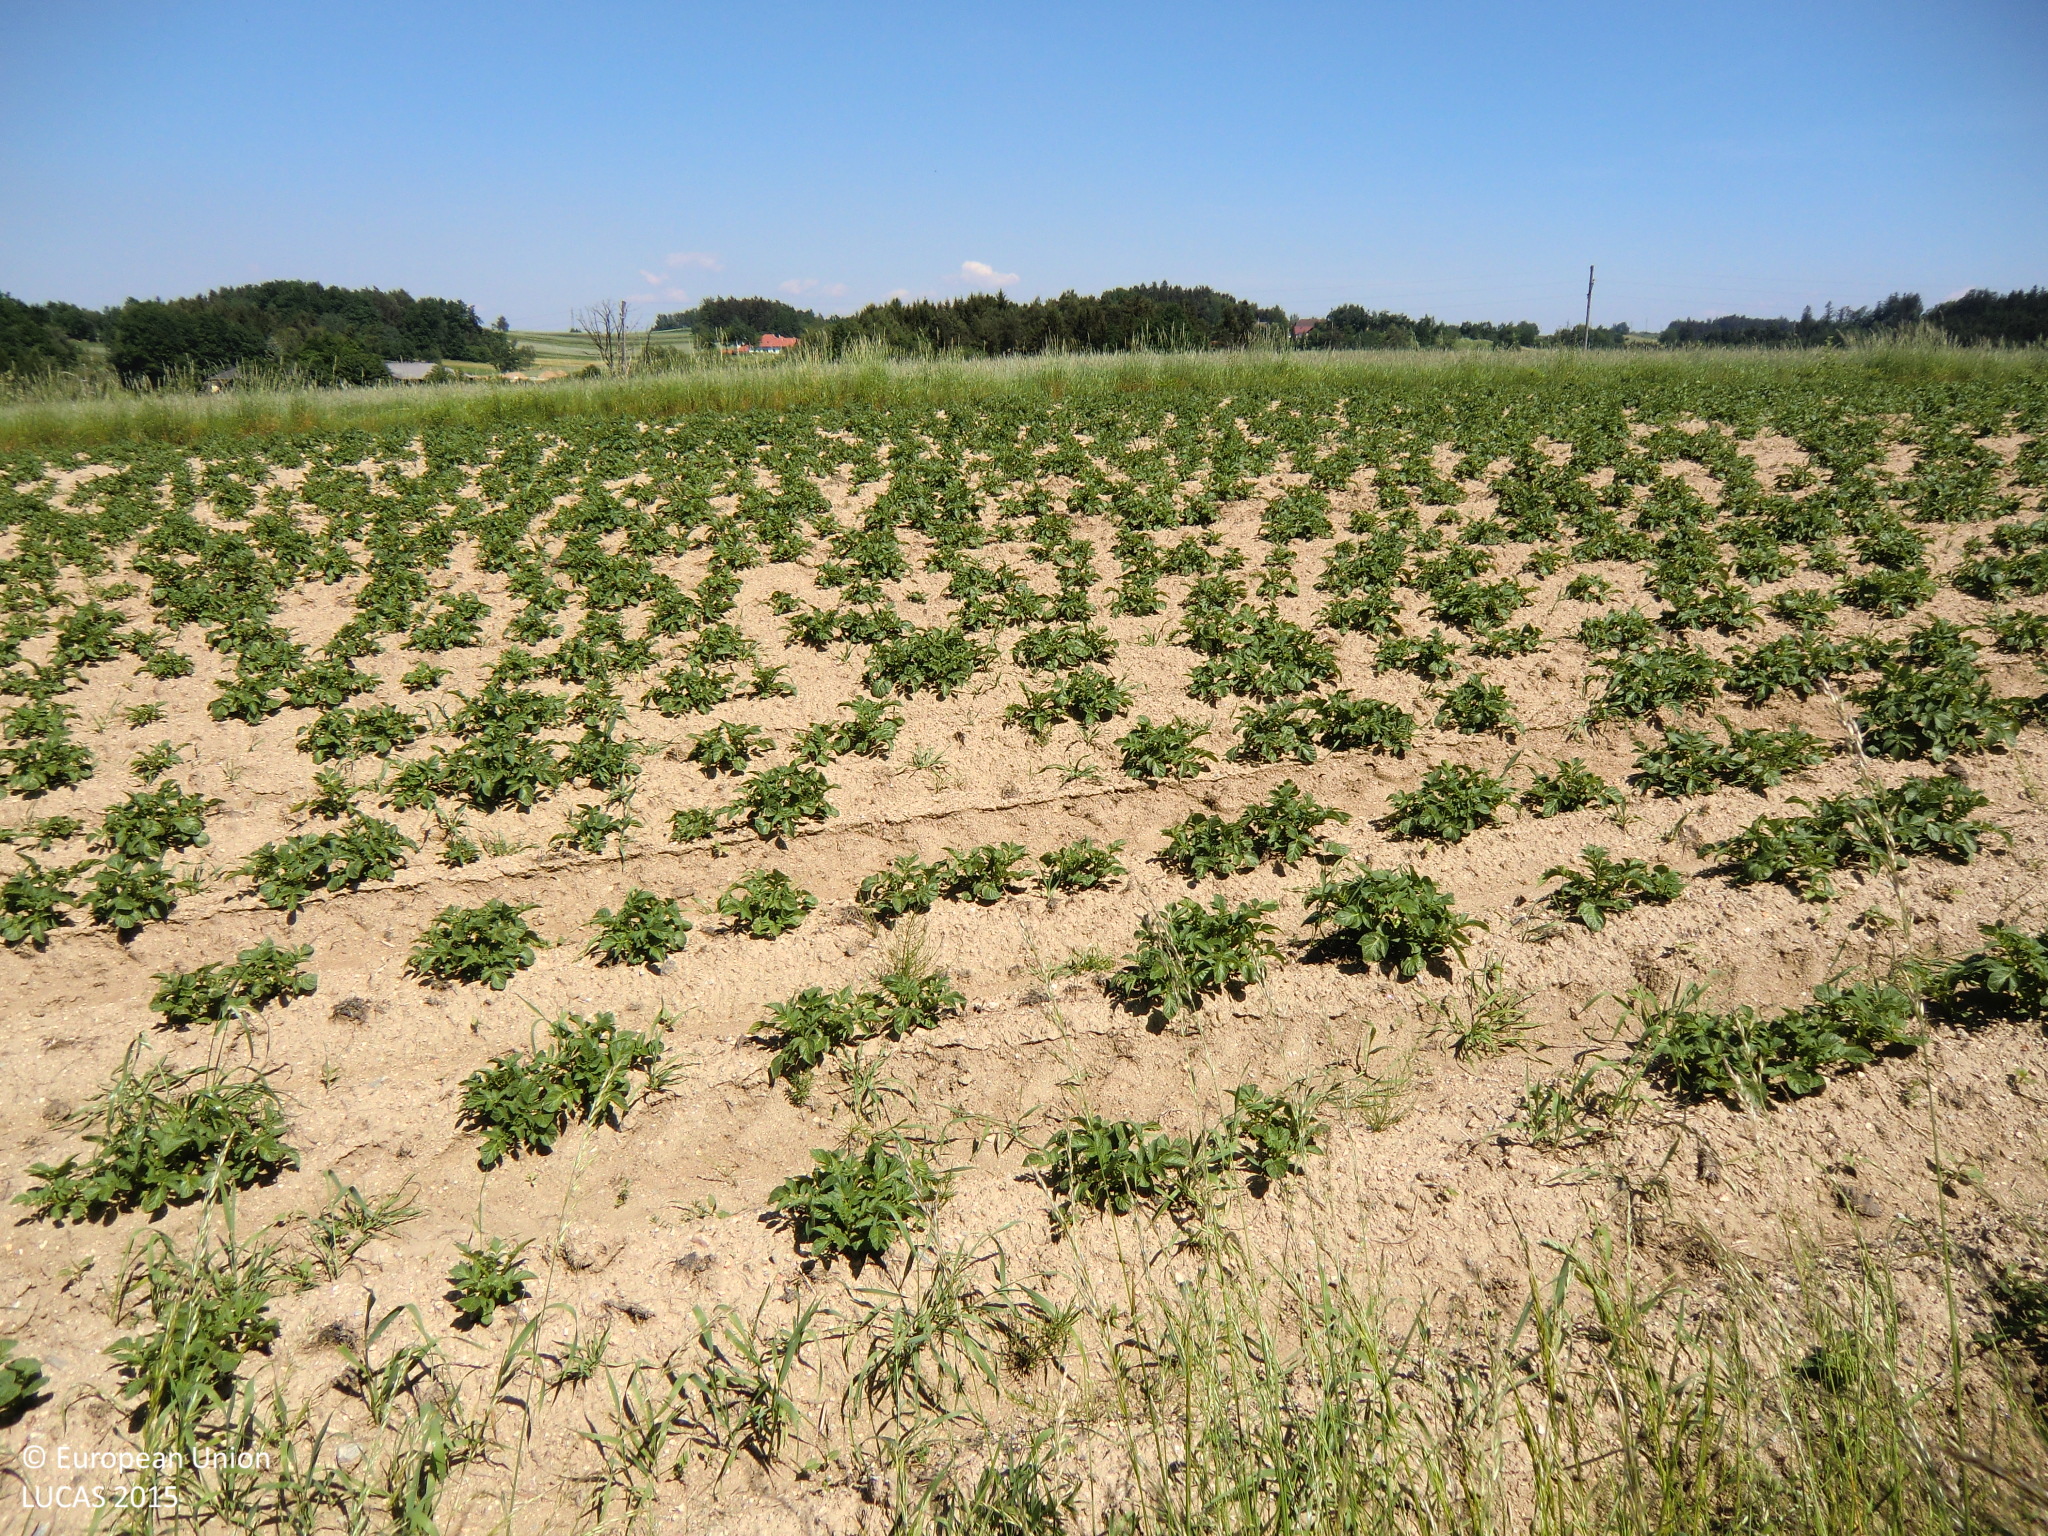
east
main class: Grassland
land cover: Grassland without tree/shrub cover
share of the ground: > 75 %
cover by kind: herbaceous plants 100 %
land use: Road transport
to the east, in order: Grassland without tree/shrub cover; Potatoes; Grass margins; Potatoes; Grass margins; Potatoes; Rye; Potatoes; Grass margins; Potatoes; Grass margins; Triticale; Common wheat; Electric lines; Common wheat; Grass margins; Sunflower; Grass margins; Sunflower; Potatoes; Grassland without tree/shrub cover; Tracks; Grassland without tree/shrub cover
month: June
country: AT
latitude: 48.7223
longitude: 15.0178
